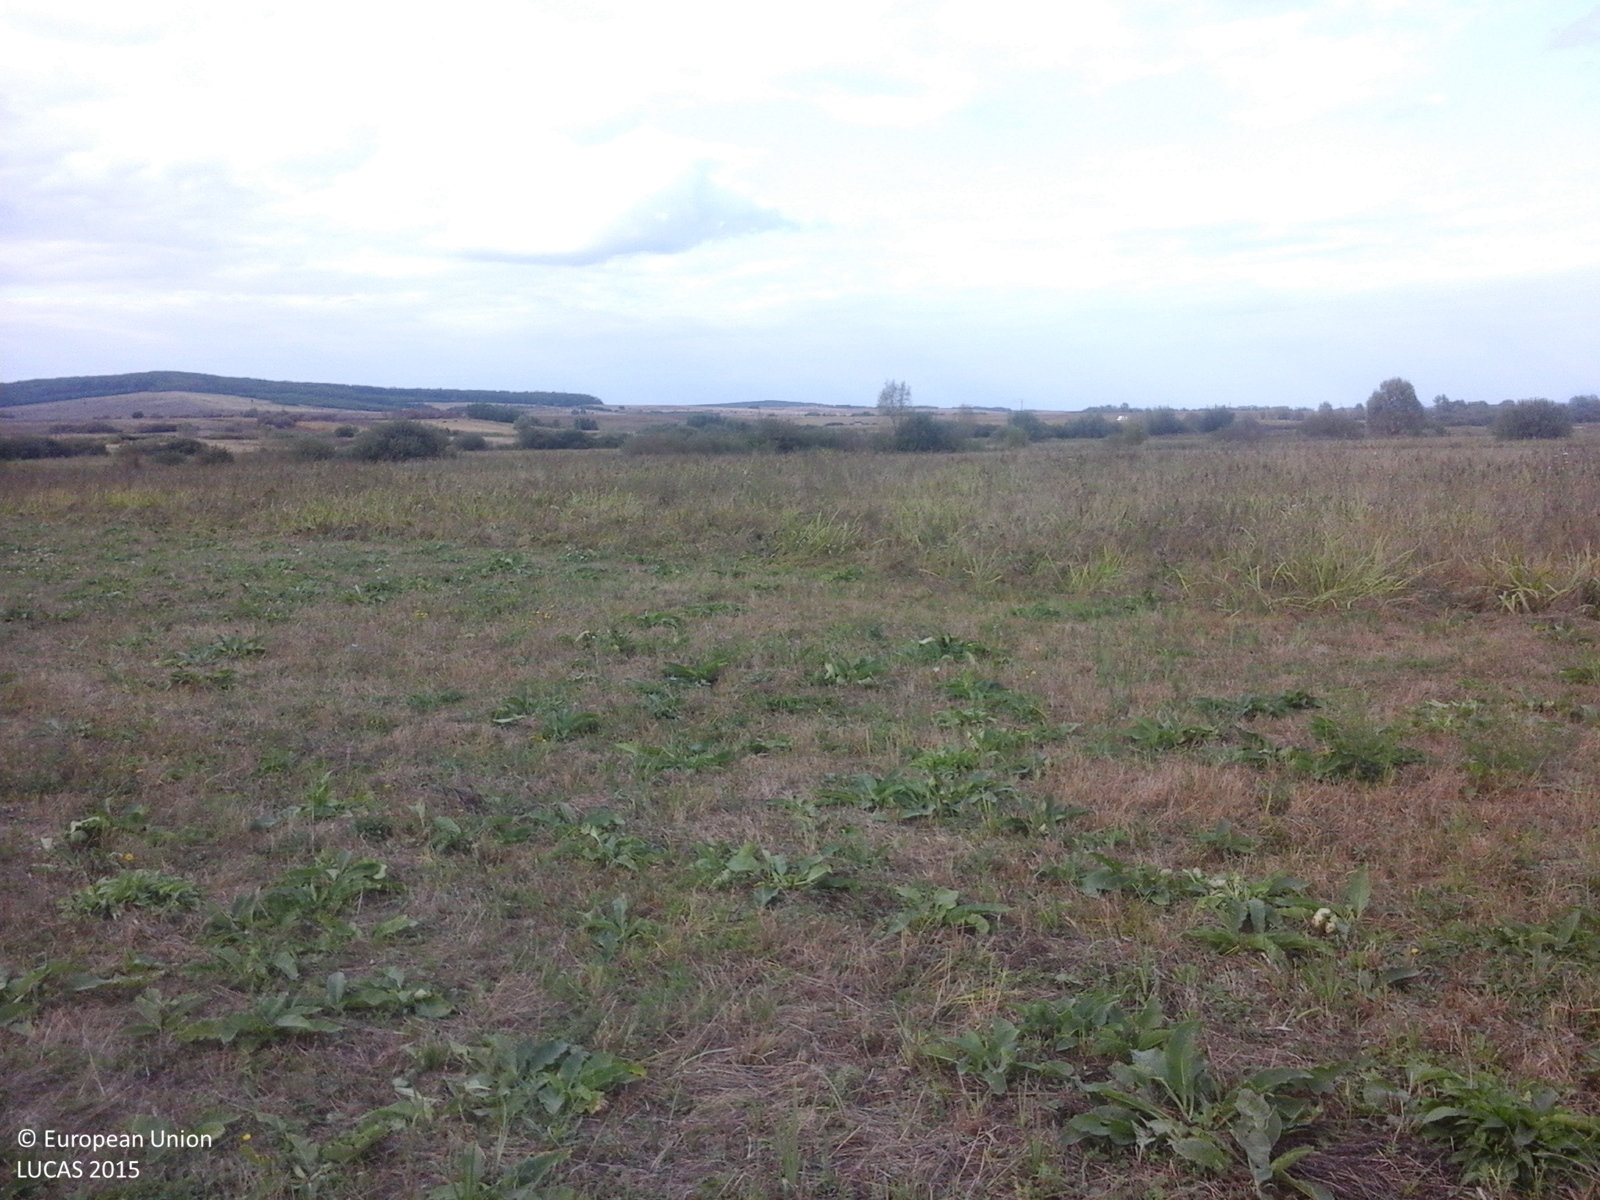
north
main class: Grassland
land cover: Grassland without tree/shrub cover
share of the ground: > 75 %
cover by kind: herbaceous plants 100 %
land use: Agriculture (excluding fallow land and kitchen gardens)
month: September
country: RO
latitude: 47.4635
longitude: 23.1882
